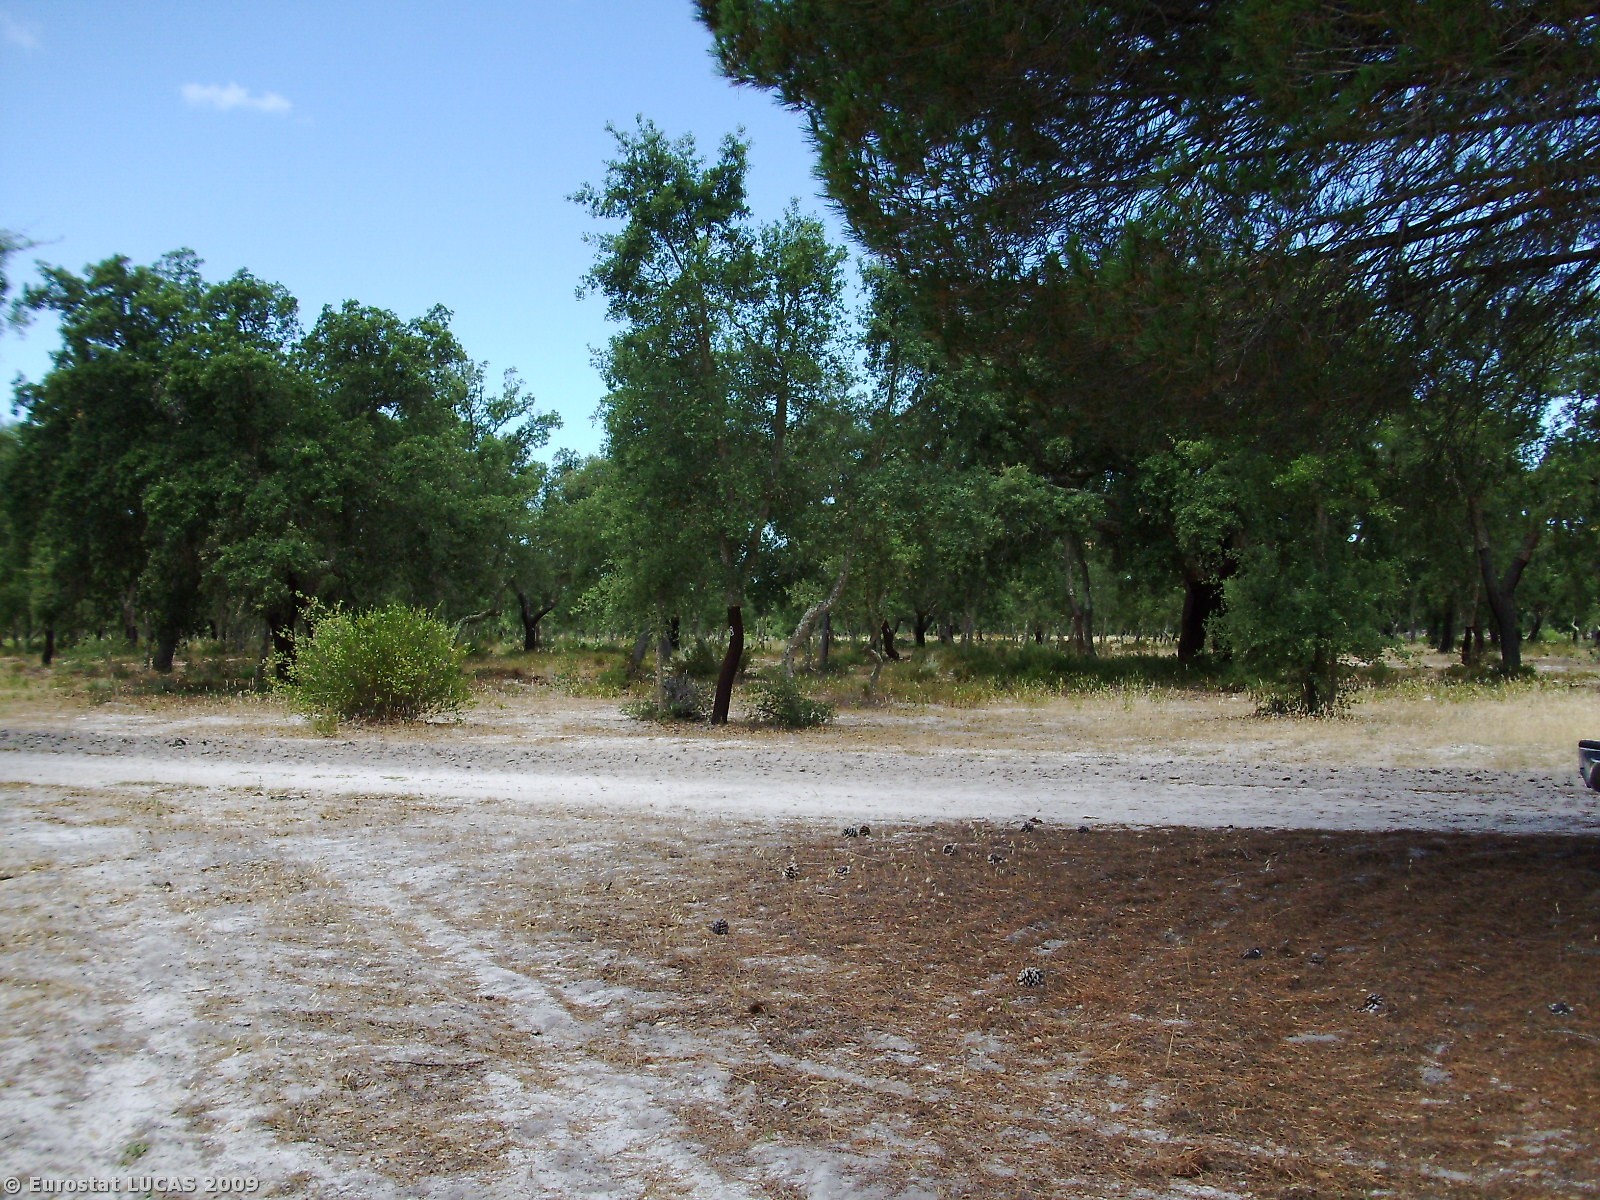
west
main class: Woodland
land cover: Broadleaved woodland
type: broadleaved evergreen forest
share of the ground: 25 - 50 %
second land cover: Spontaneously vegetated surfaces
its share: 10 - 25 %
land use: Forestry
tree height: > 5 m
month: June
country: PT
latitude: 38.2538
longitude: -8.5741
